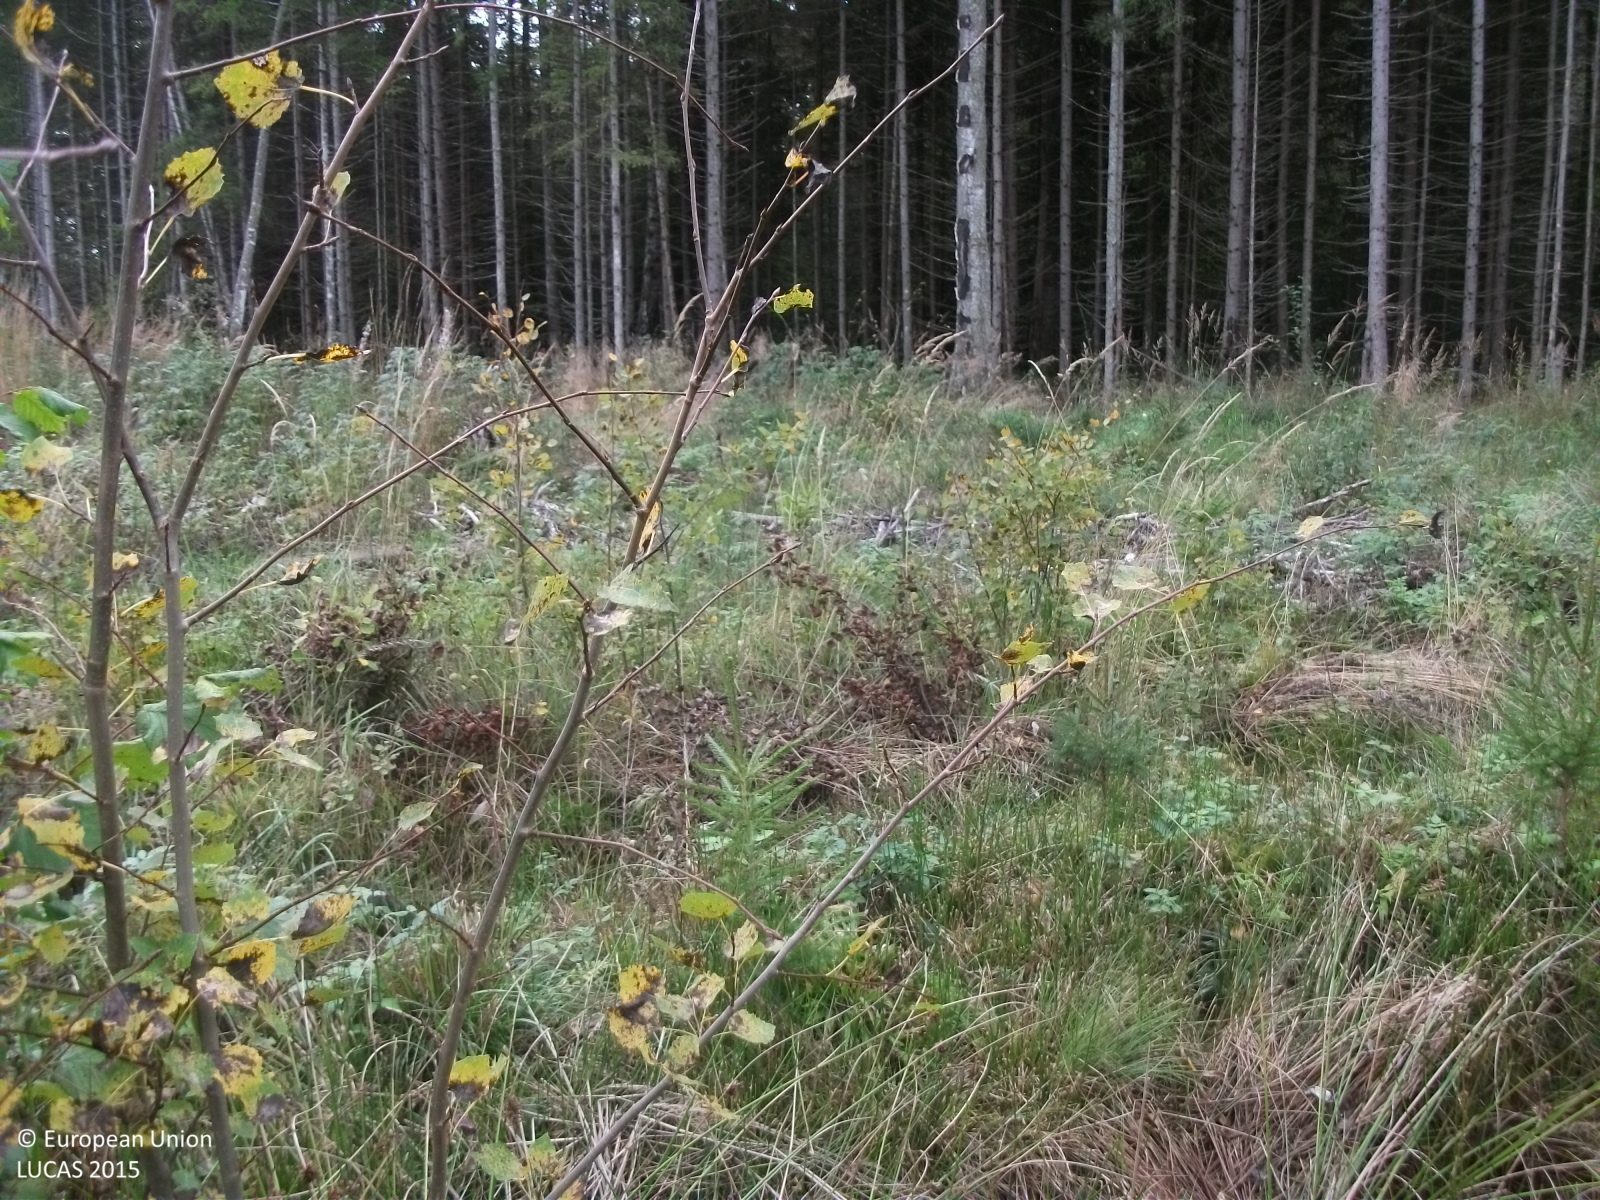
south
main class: Grassland
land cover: Grassland with sparse tree/shrub cover
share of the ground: > 75 %
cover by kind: herbaceous plants 90 %, coniferous forest trees 5 %, shrubs 5 %
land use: Forestry
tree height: < 5 m
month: September
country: LV
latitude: 57.6519
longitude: 24.6211
